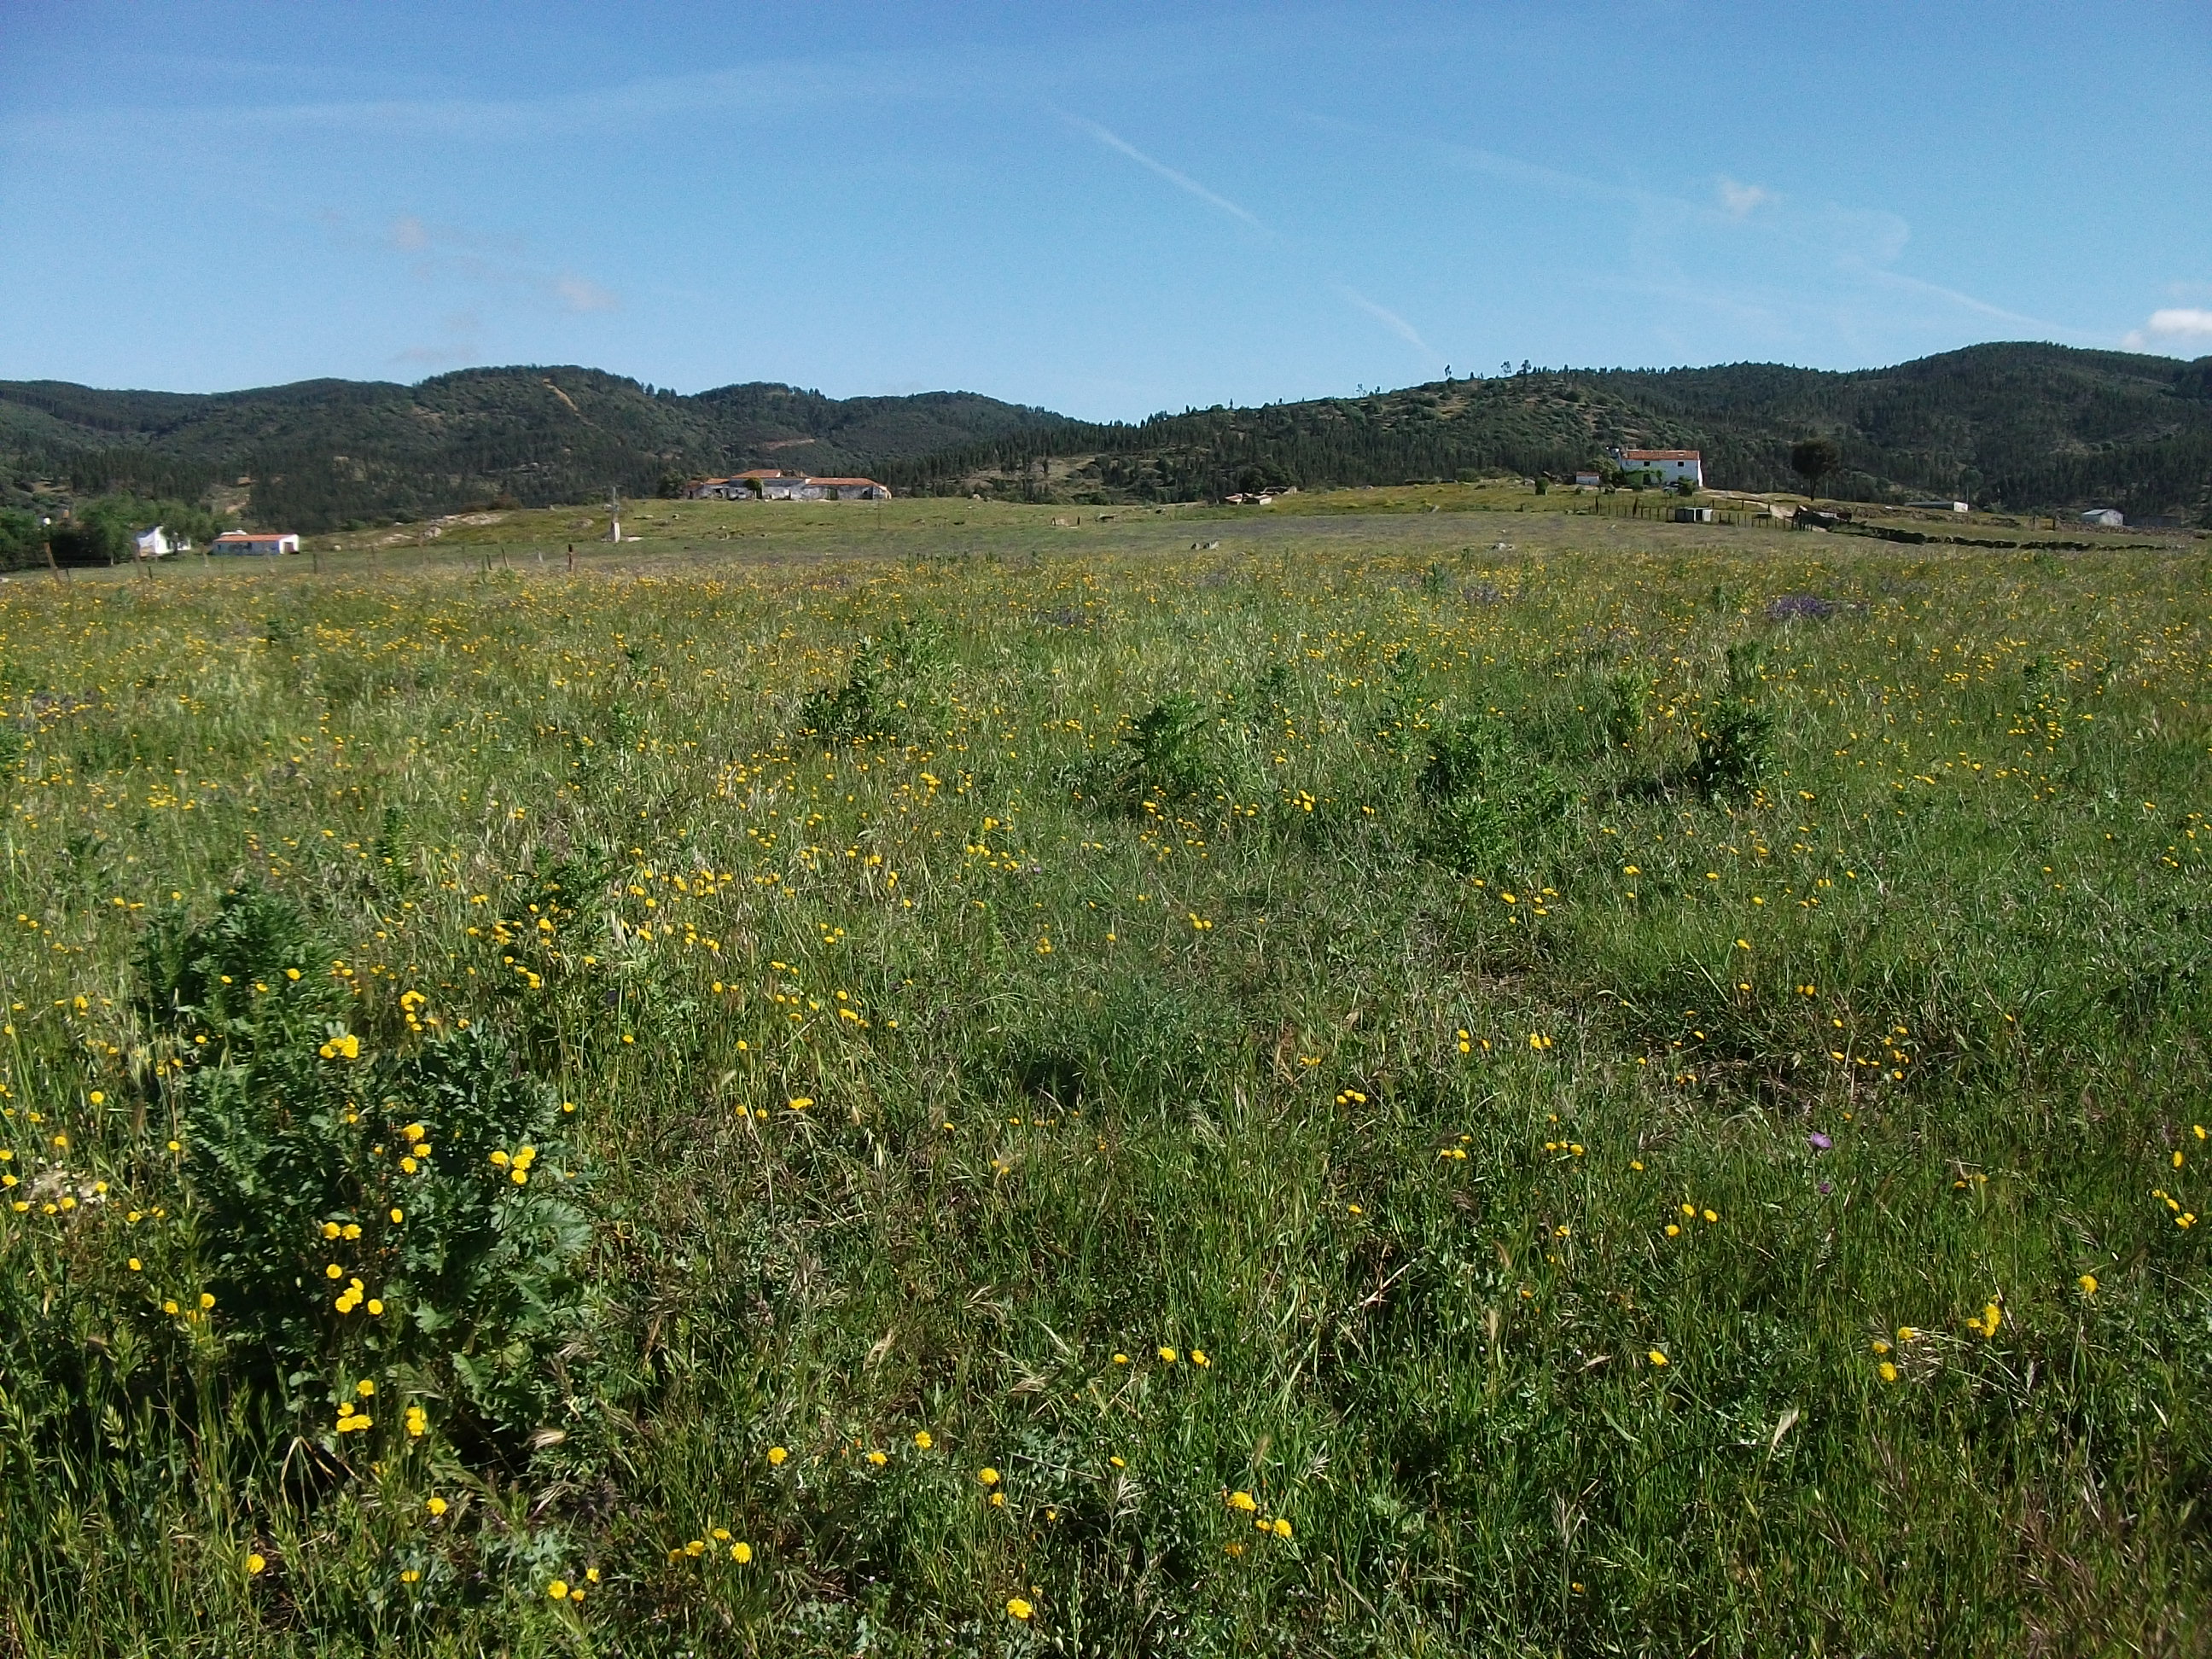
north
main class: Grassland
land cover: Grassland without tree/shrub cover
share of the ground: > 75 %
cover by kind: herbaceous plants 100 %
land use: Agriculture (excluding fallow land and kitchen gardens)
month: April
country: ES
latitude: 37.9786
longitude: -7.0984
